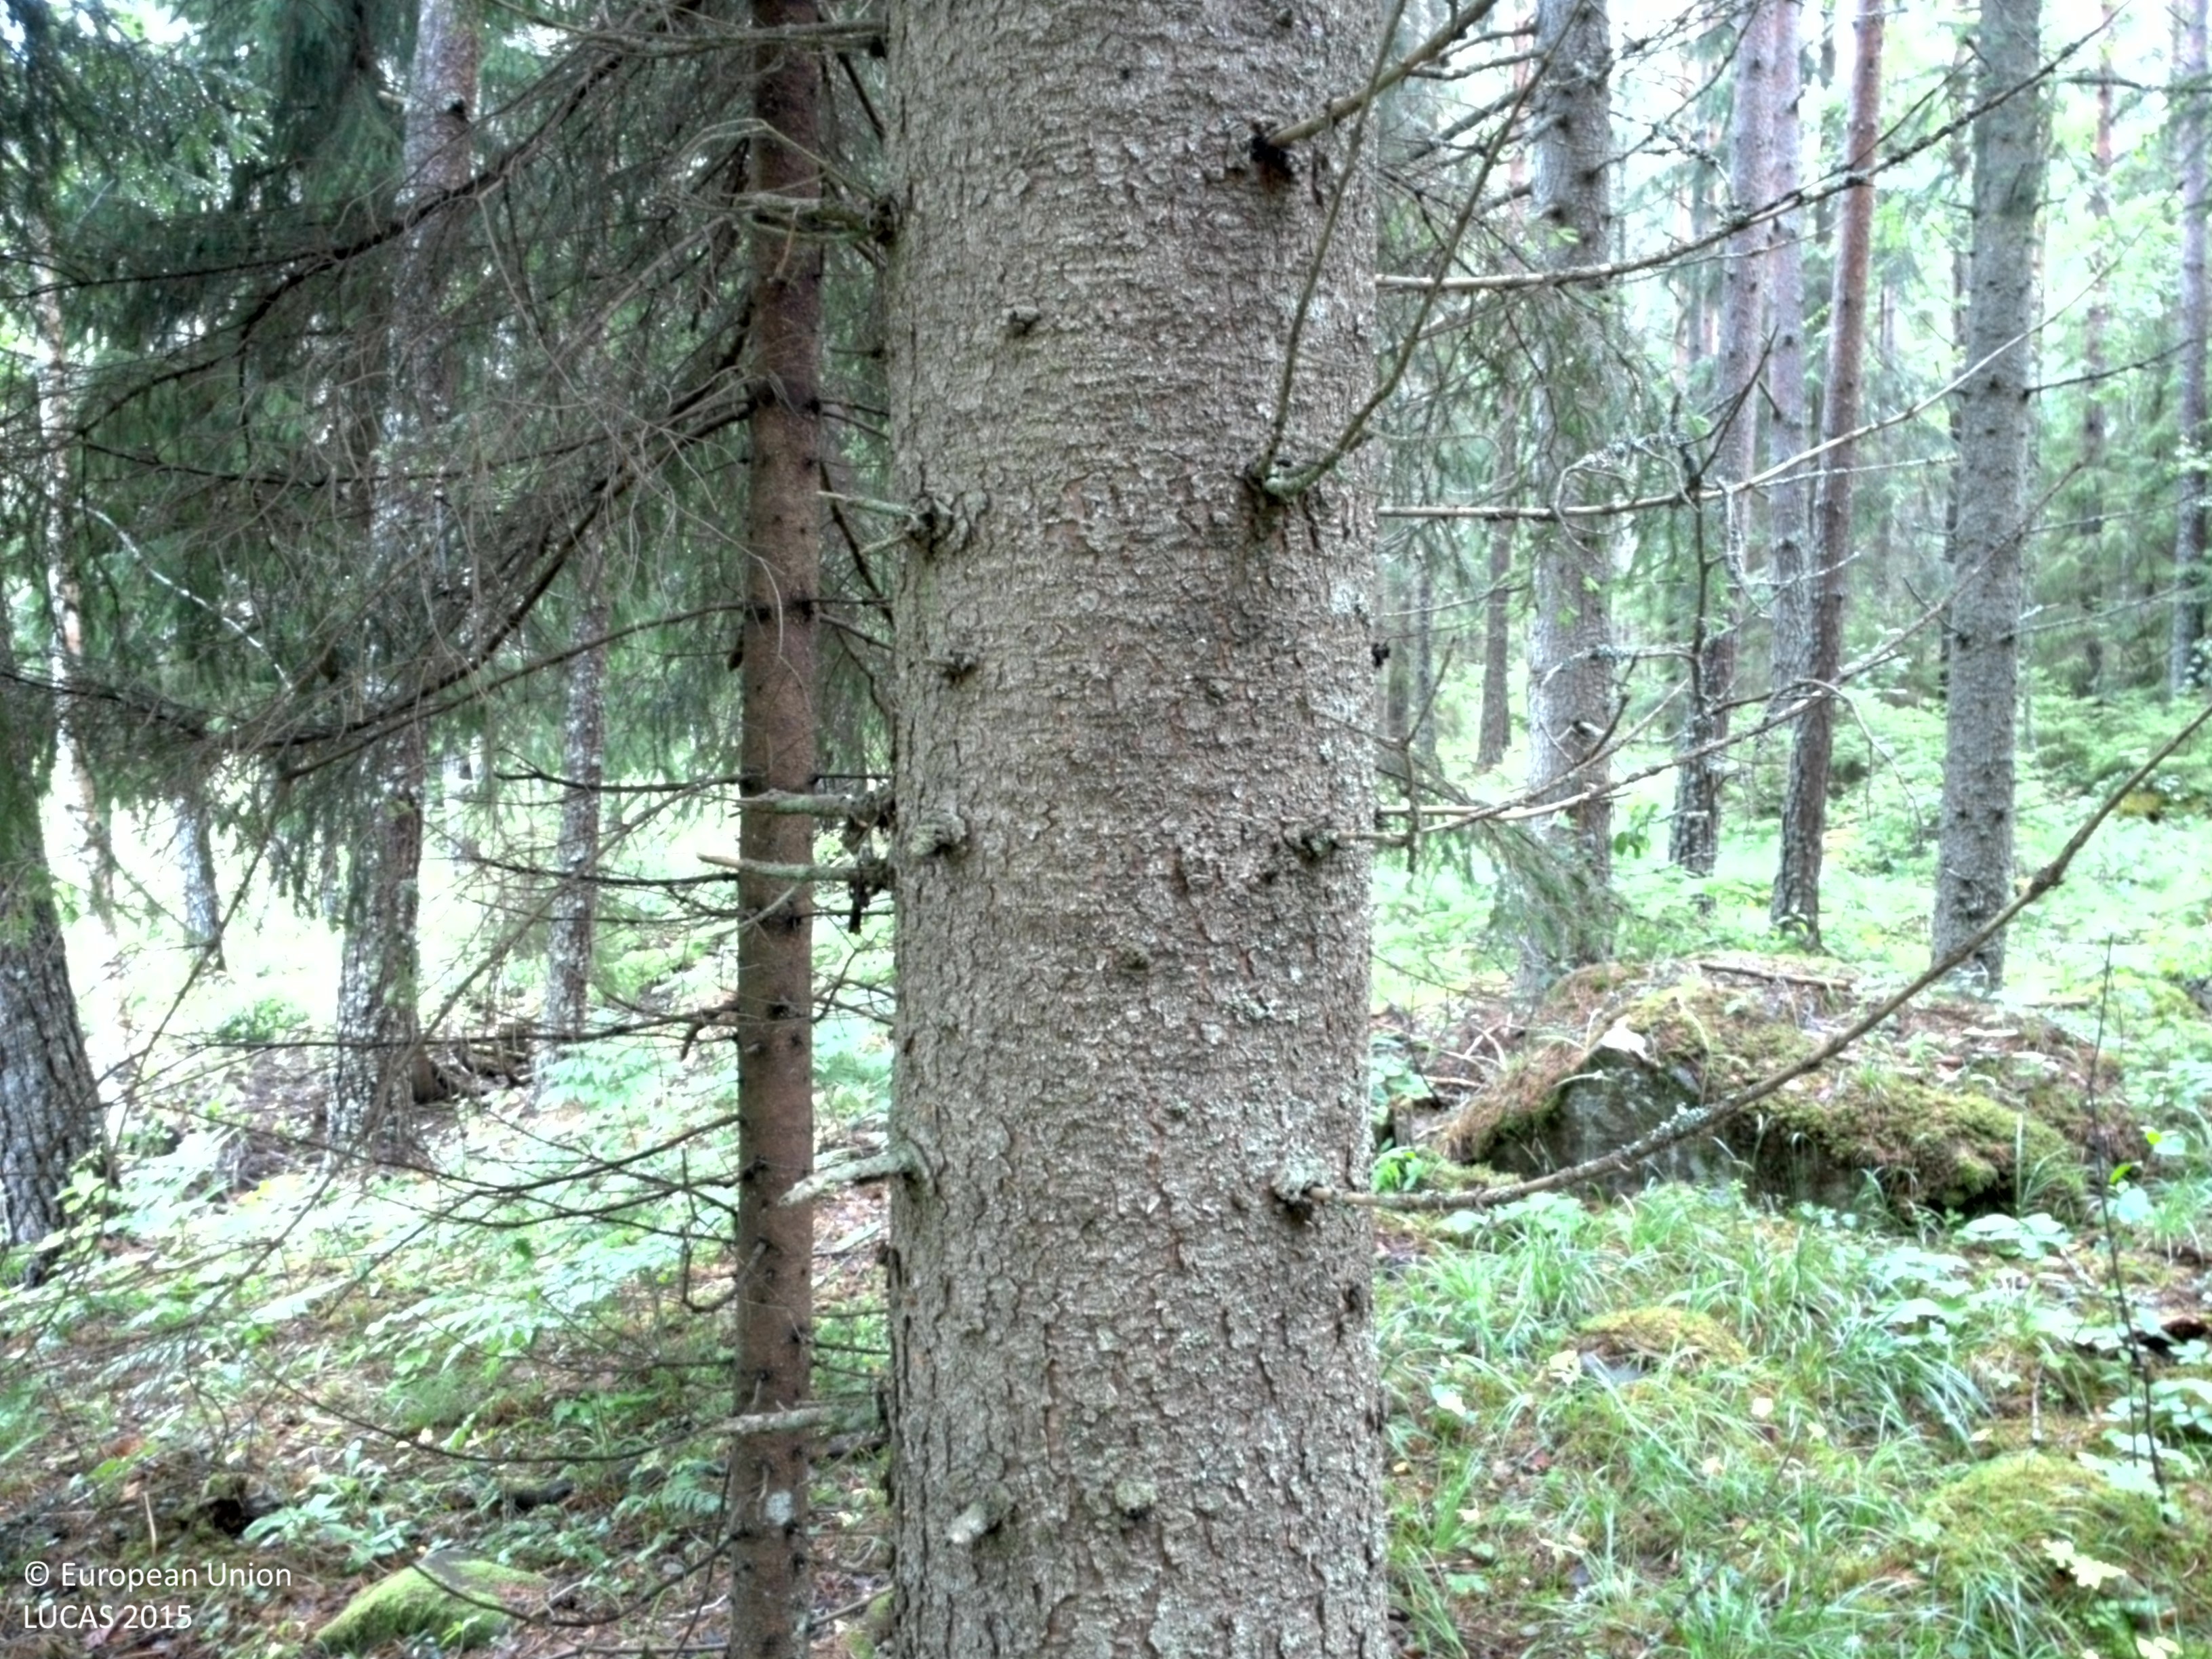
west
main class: Woodland
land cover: Other coniferous woodland
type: boreal forest
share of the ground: > 75 %
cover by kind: coniferous forest trees 65 %, lichens and mosses 20 %, broadleaved forest trees 10 %, herbaceous plants 5 %
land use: Forestry
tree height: > 5 m
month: July
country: SE
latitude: 60.1068
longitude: 17.1690
